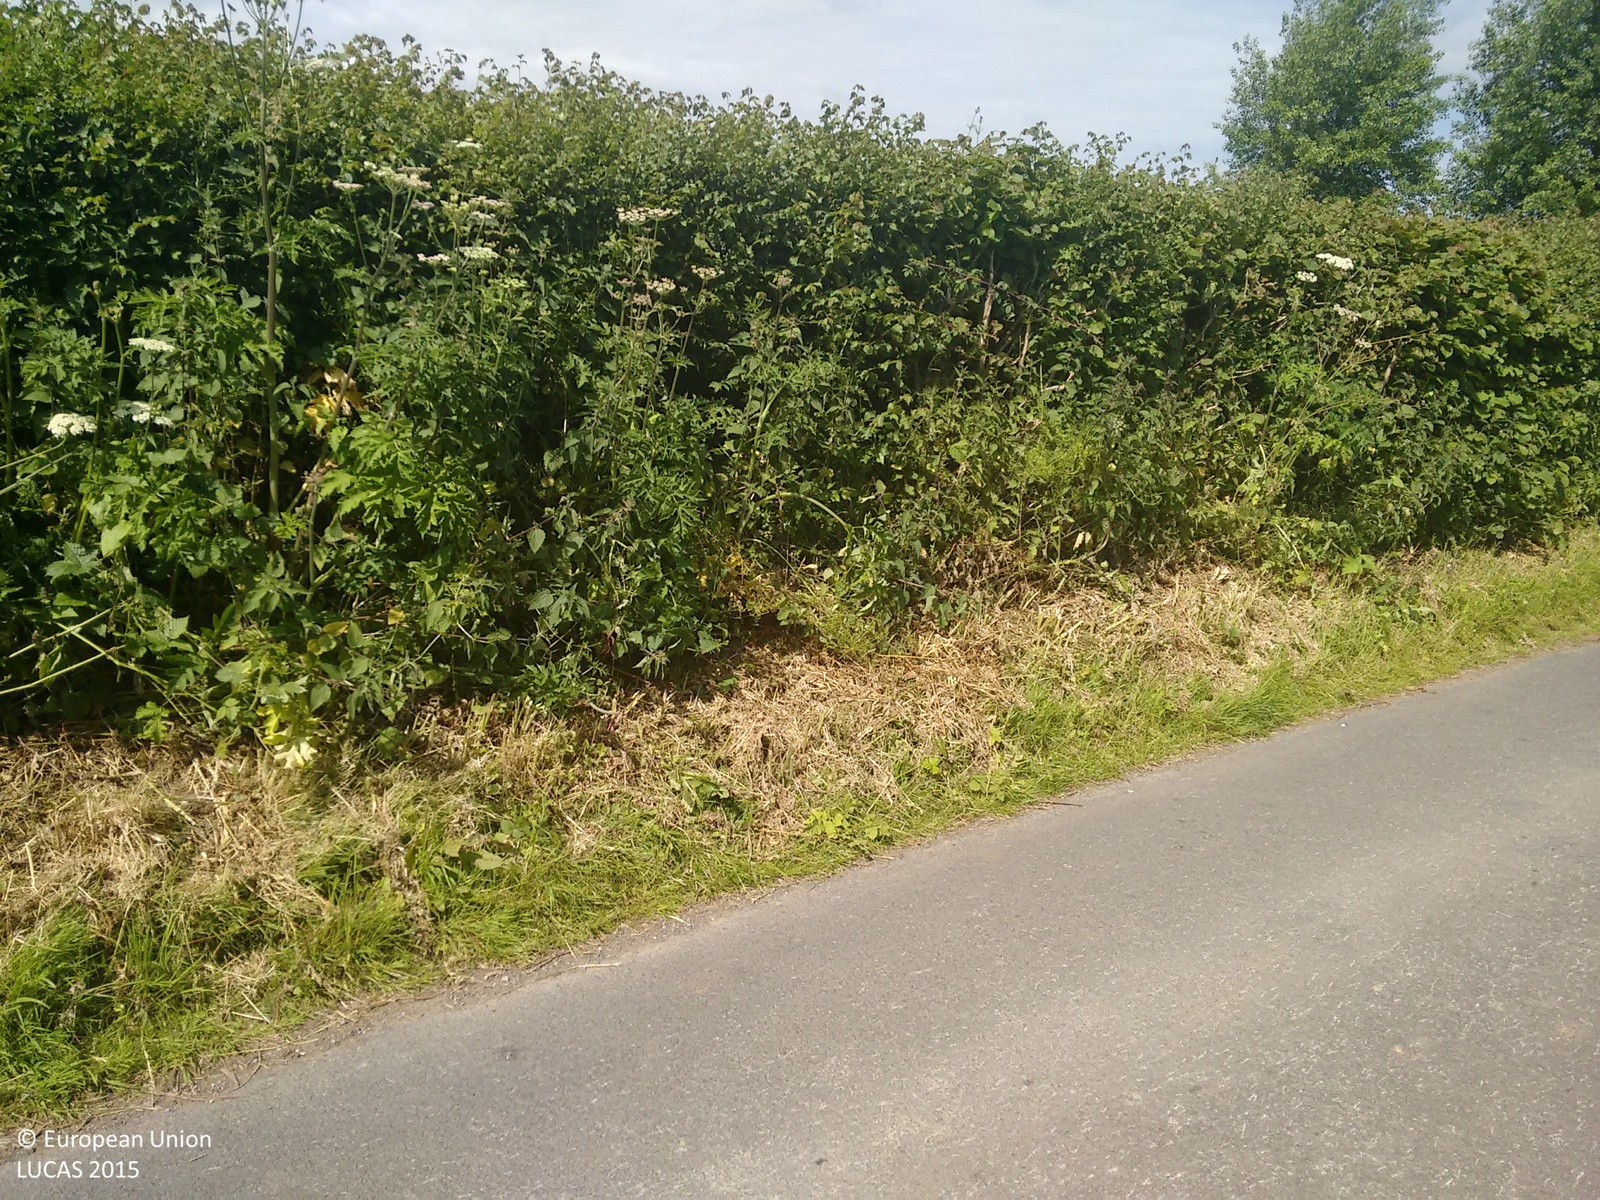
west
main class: Grassland
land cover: Grassland without tree/shrub cover
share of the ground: > 75 %
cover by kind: herbaceous plants 100 %
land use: Agriculture (excluding fallow land and kitchen gardens)
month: June
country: GB
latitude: 51.5020
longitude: -2.2646
